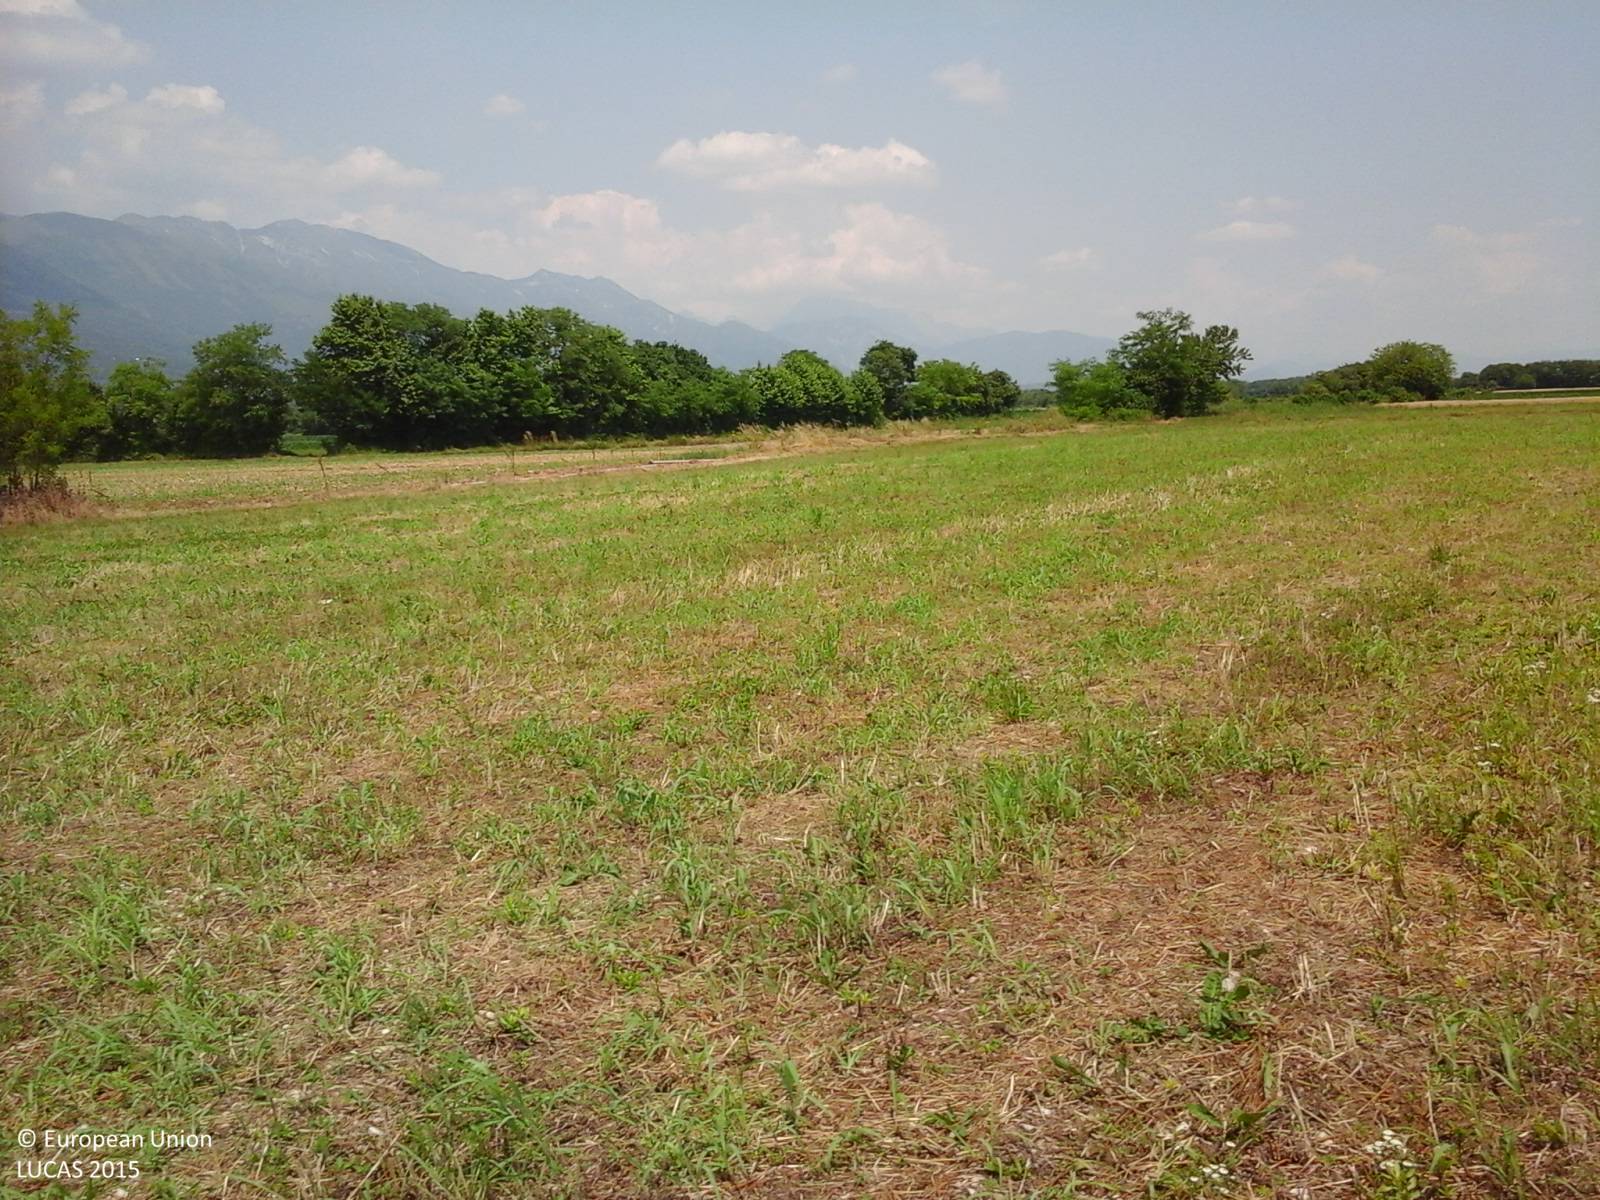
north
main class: Grassland
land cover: Grassland without tree/shrub cover
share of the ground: 50 - 75 %
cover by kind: herbaceous plants 100 %
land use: Agriculture (excluding fallow land and kitchen gardens)
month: June
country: IT
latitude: 46.0320
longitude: 12.5678
